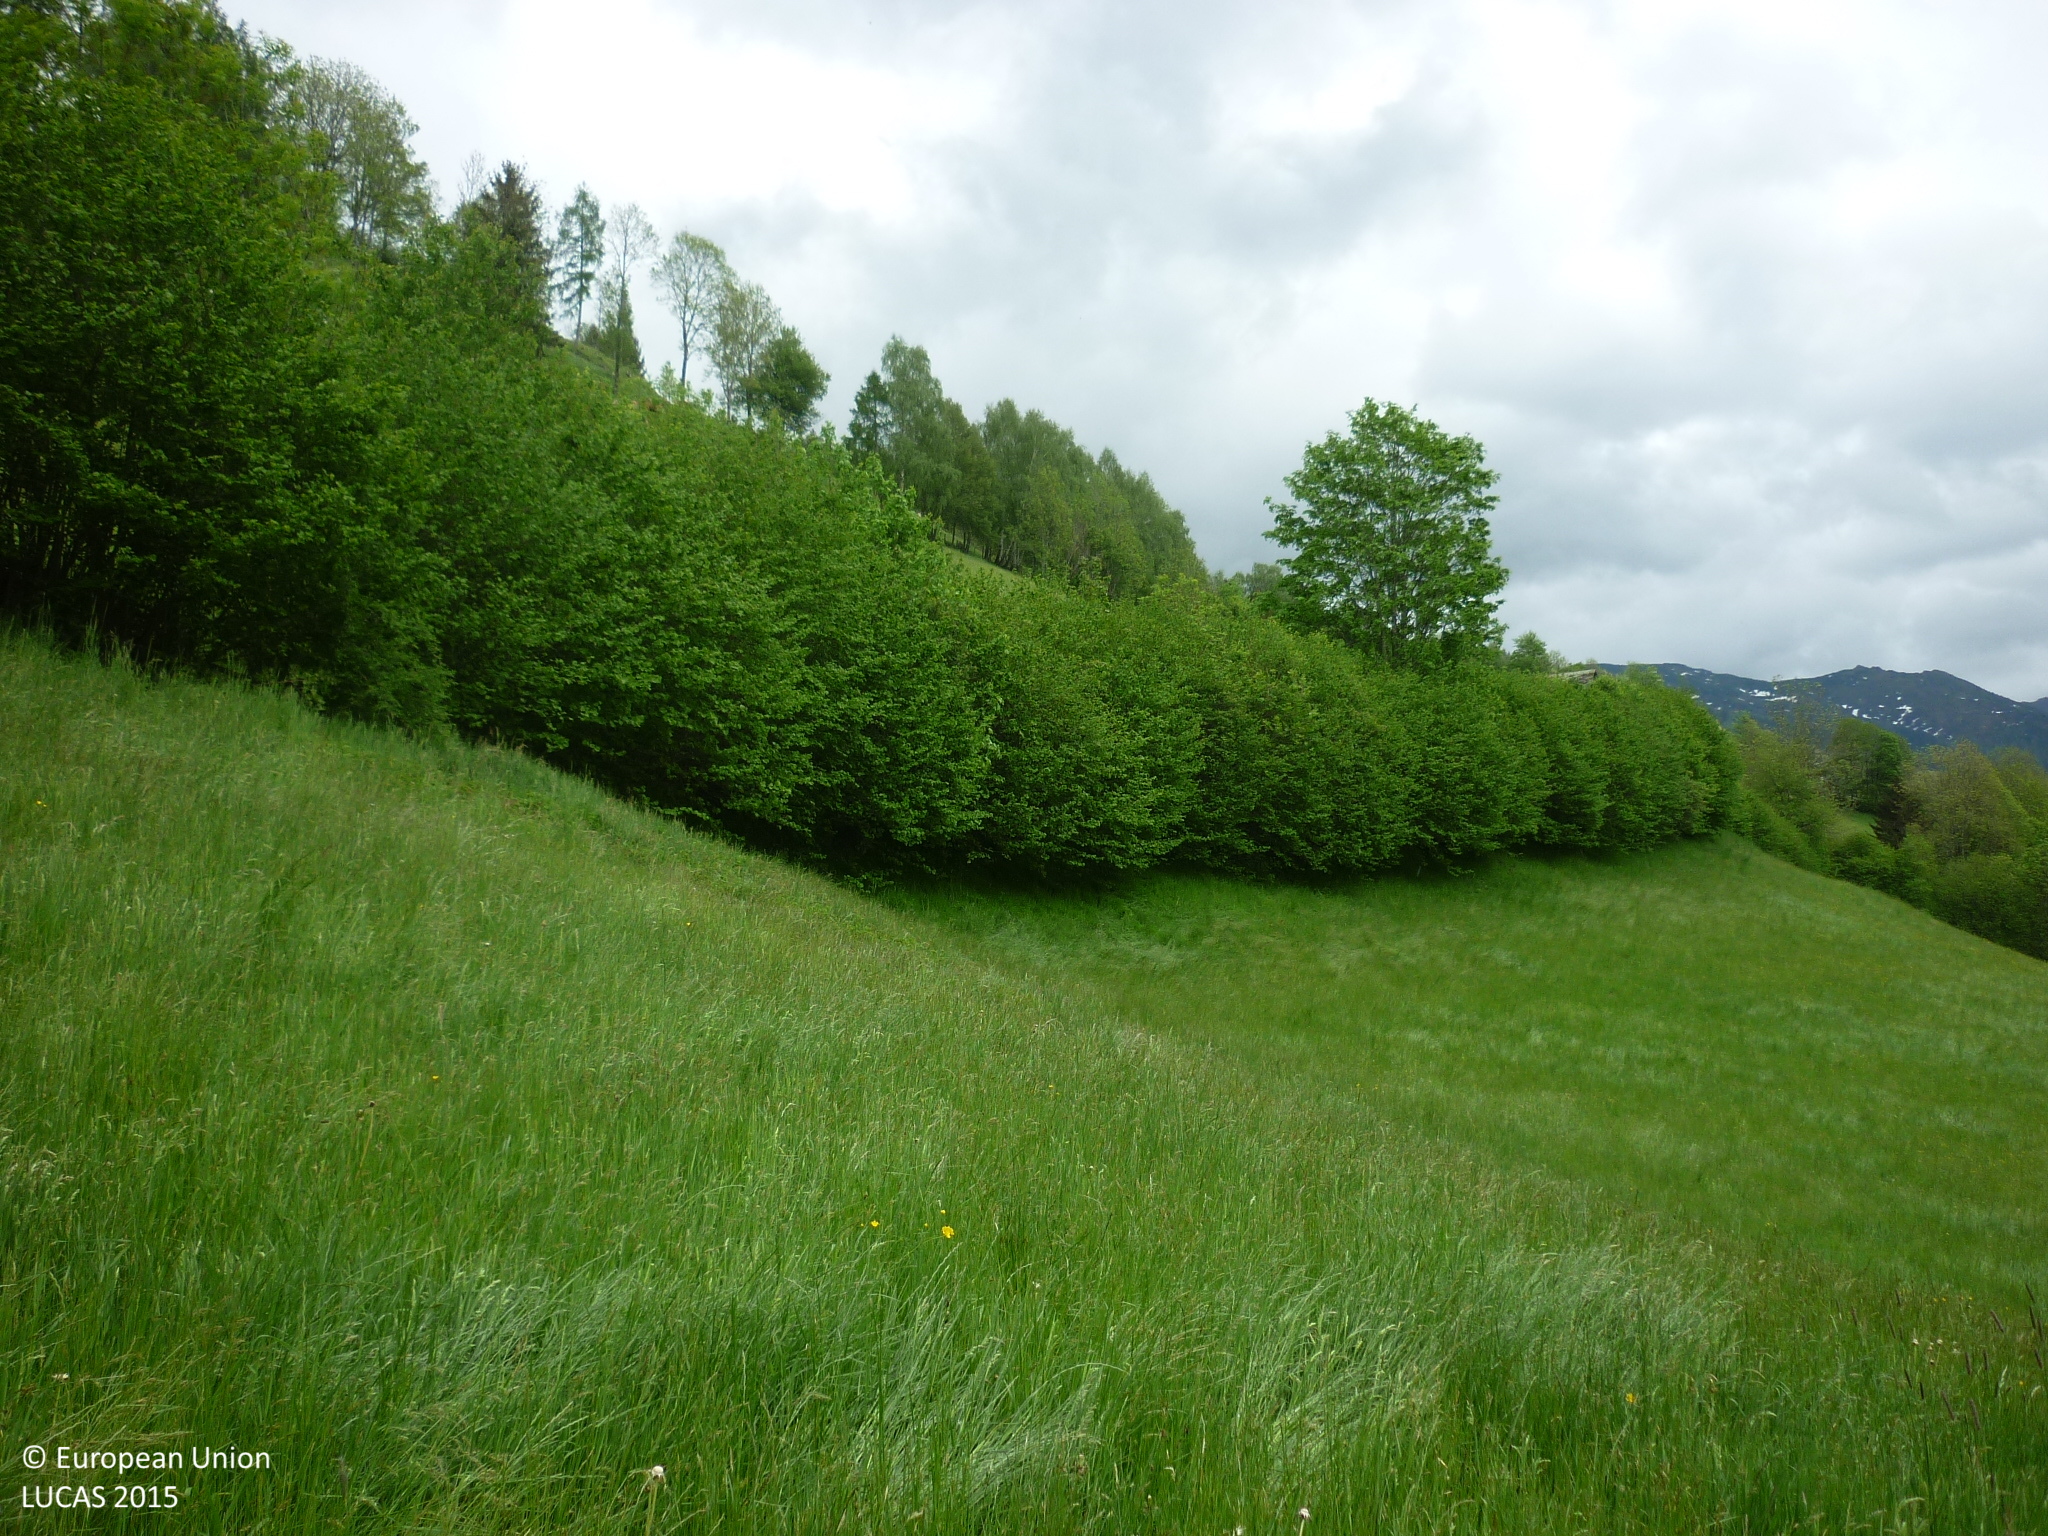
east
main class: Grassland
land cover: Grassland without tree/shrub cover
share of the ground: > 75 %
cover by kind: herbaceous plants 100 %
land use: Agriculture (excluding fallow land and kitchen gardens)
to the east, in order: Grassland without tree/shrub cover; Abandoned hedges; Fences; Abandoned hedges; Grassland without tree/shrub cover; Tracks; Grassland without tree/shrub cover; Tracks; Grassland with sparse tree/shrub cover; Fences; Grassland without tree/shrub cover; Other mixed woodland; Fences; Grass margins; Tracks; Grass margins; Fences; Grassland without tree/shrub cover; Fences; Broadleaved woodland; Grassland without tree/shrub cover
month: May
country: AT
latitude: 47.4796
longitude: 14.1258
